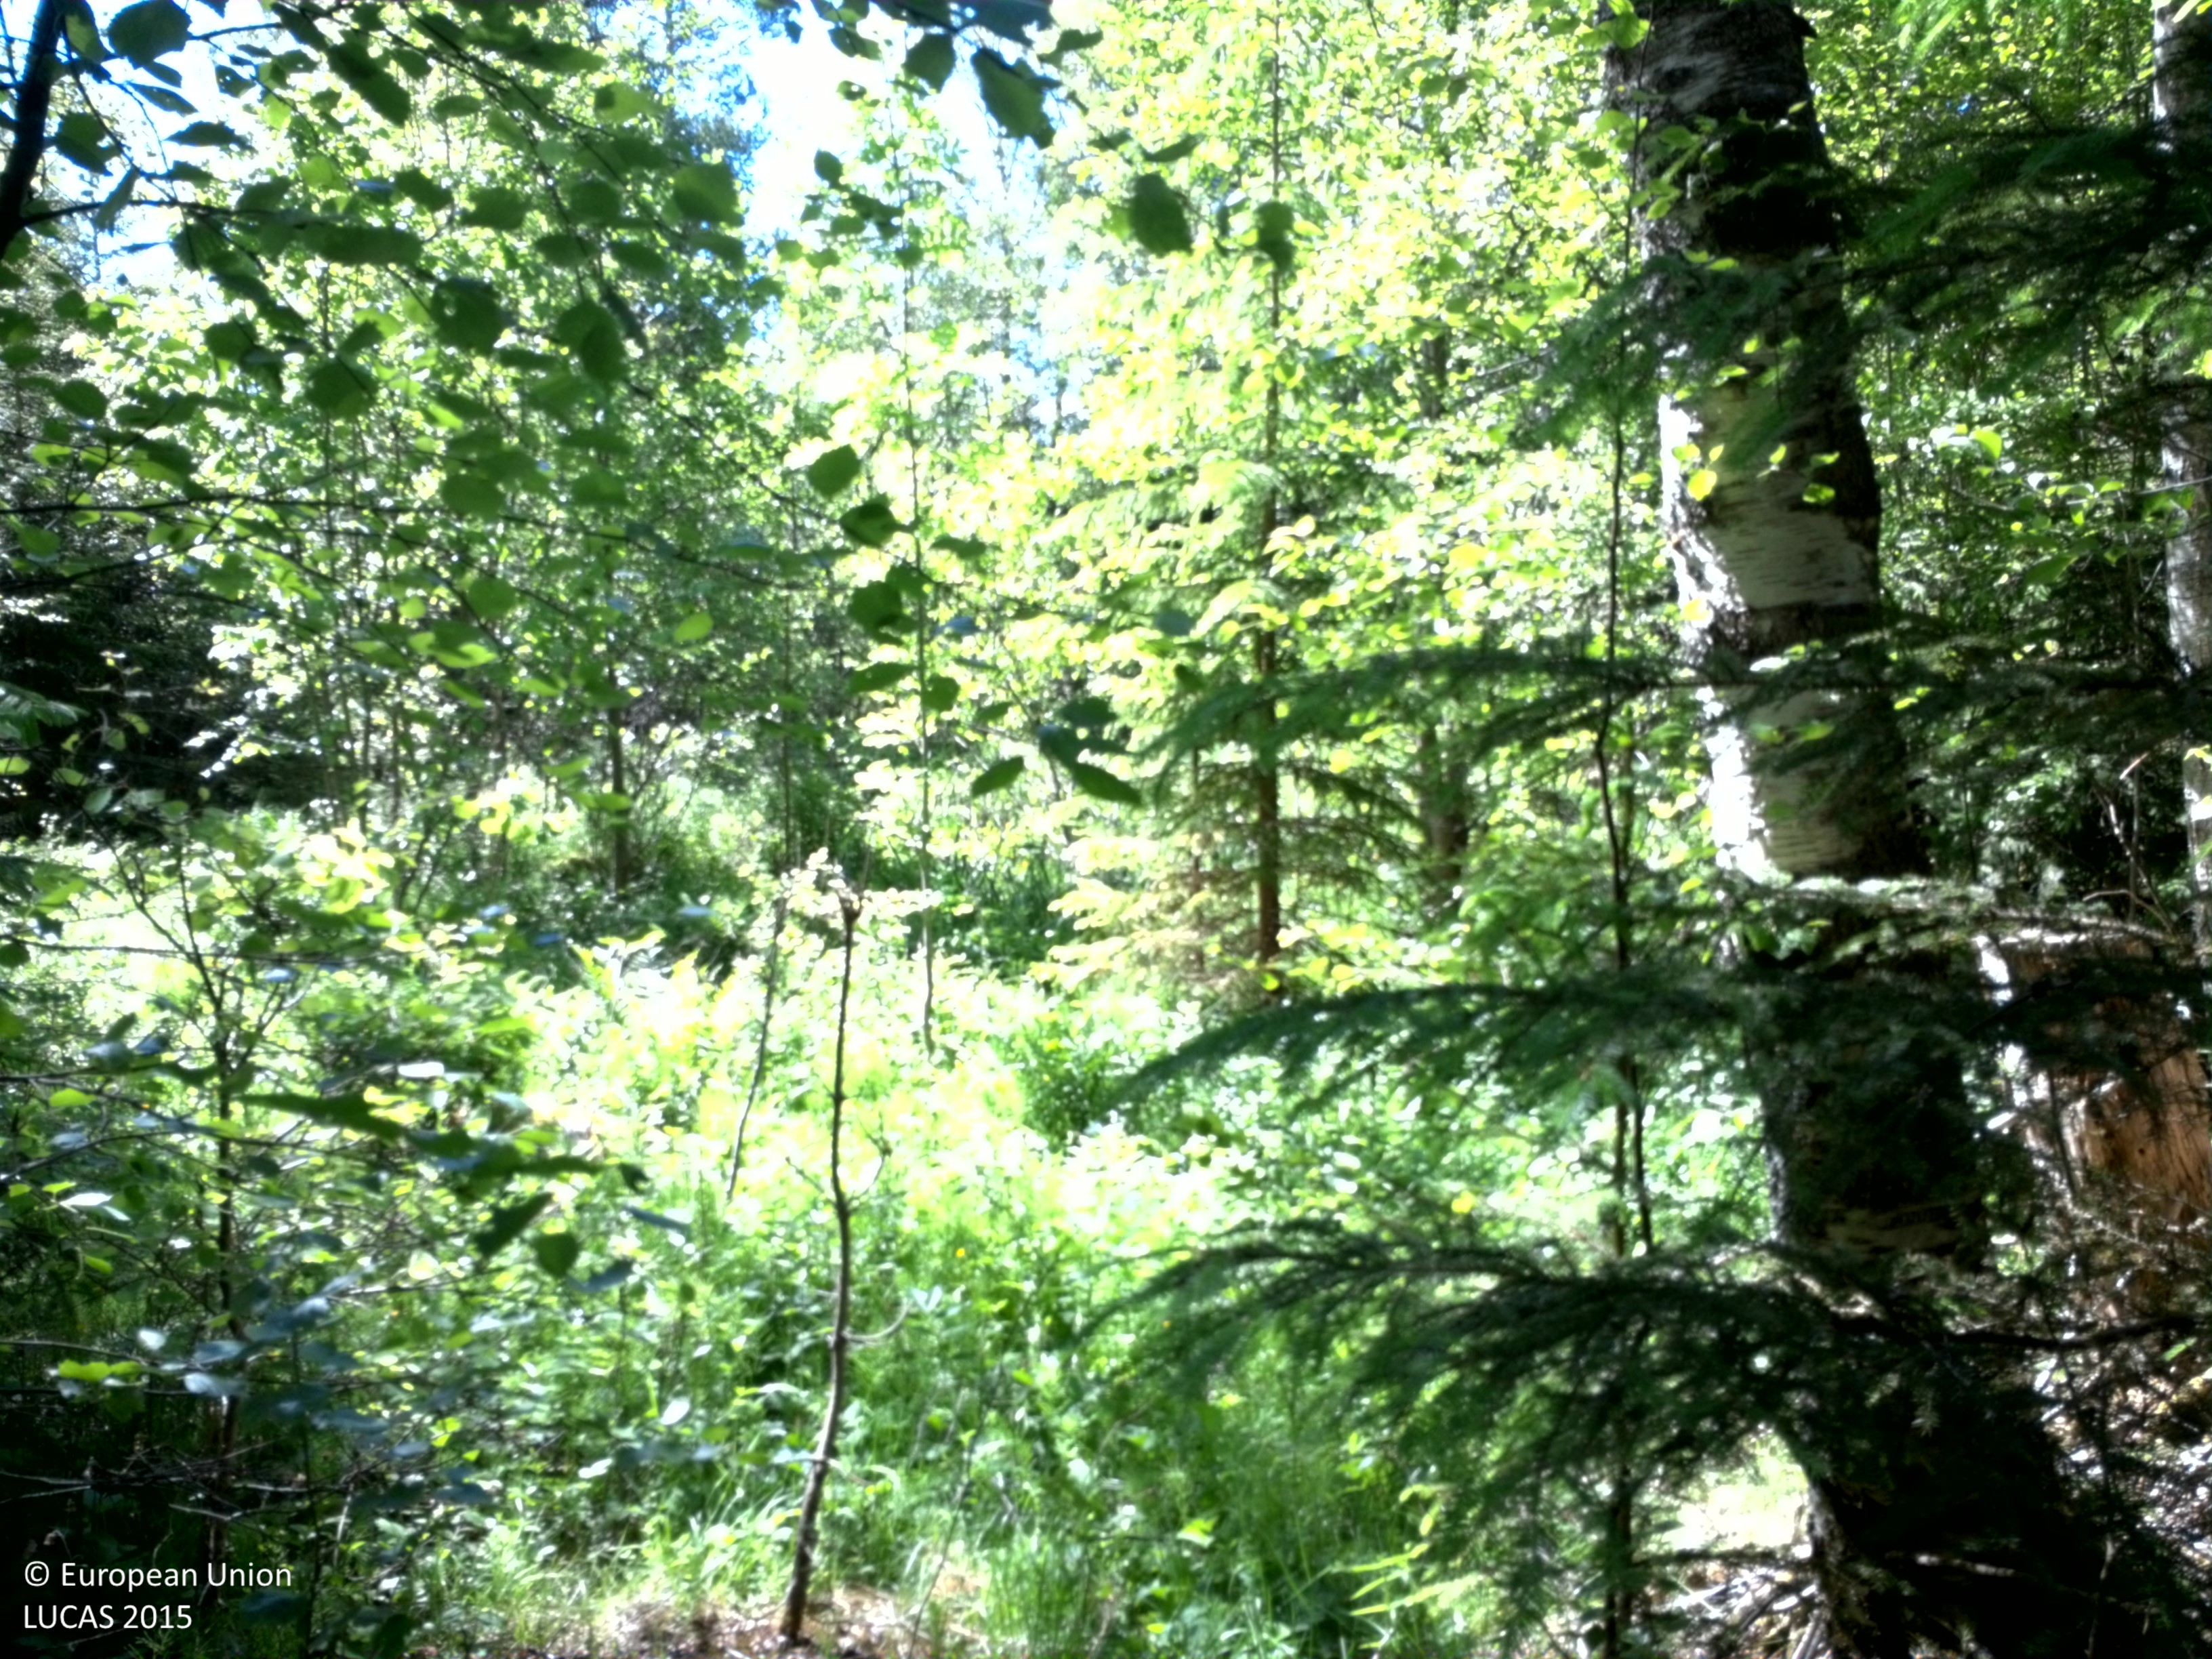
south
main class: Woodland
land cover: Broadleaved woodland
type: boreal forest
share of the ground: > 75 %
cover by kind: broadleaved forest trees 80 %, coniferous forest trees 10 %, herbaceous plants 10 %
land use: Forestry
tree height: > 5 m
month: June
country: SE
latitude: 58.6311
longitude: 14.4885
